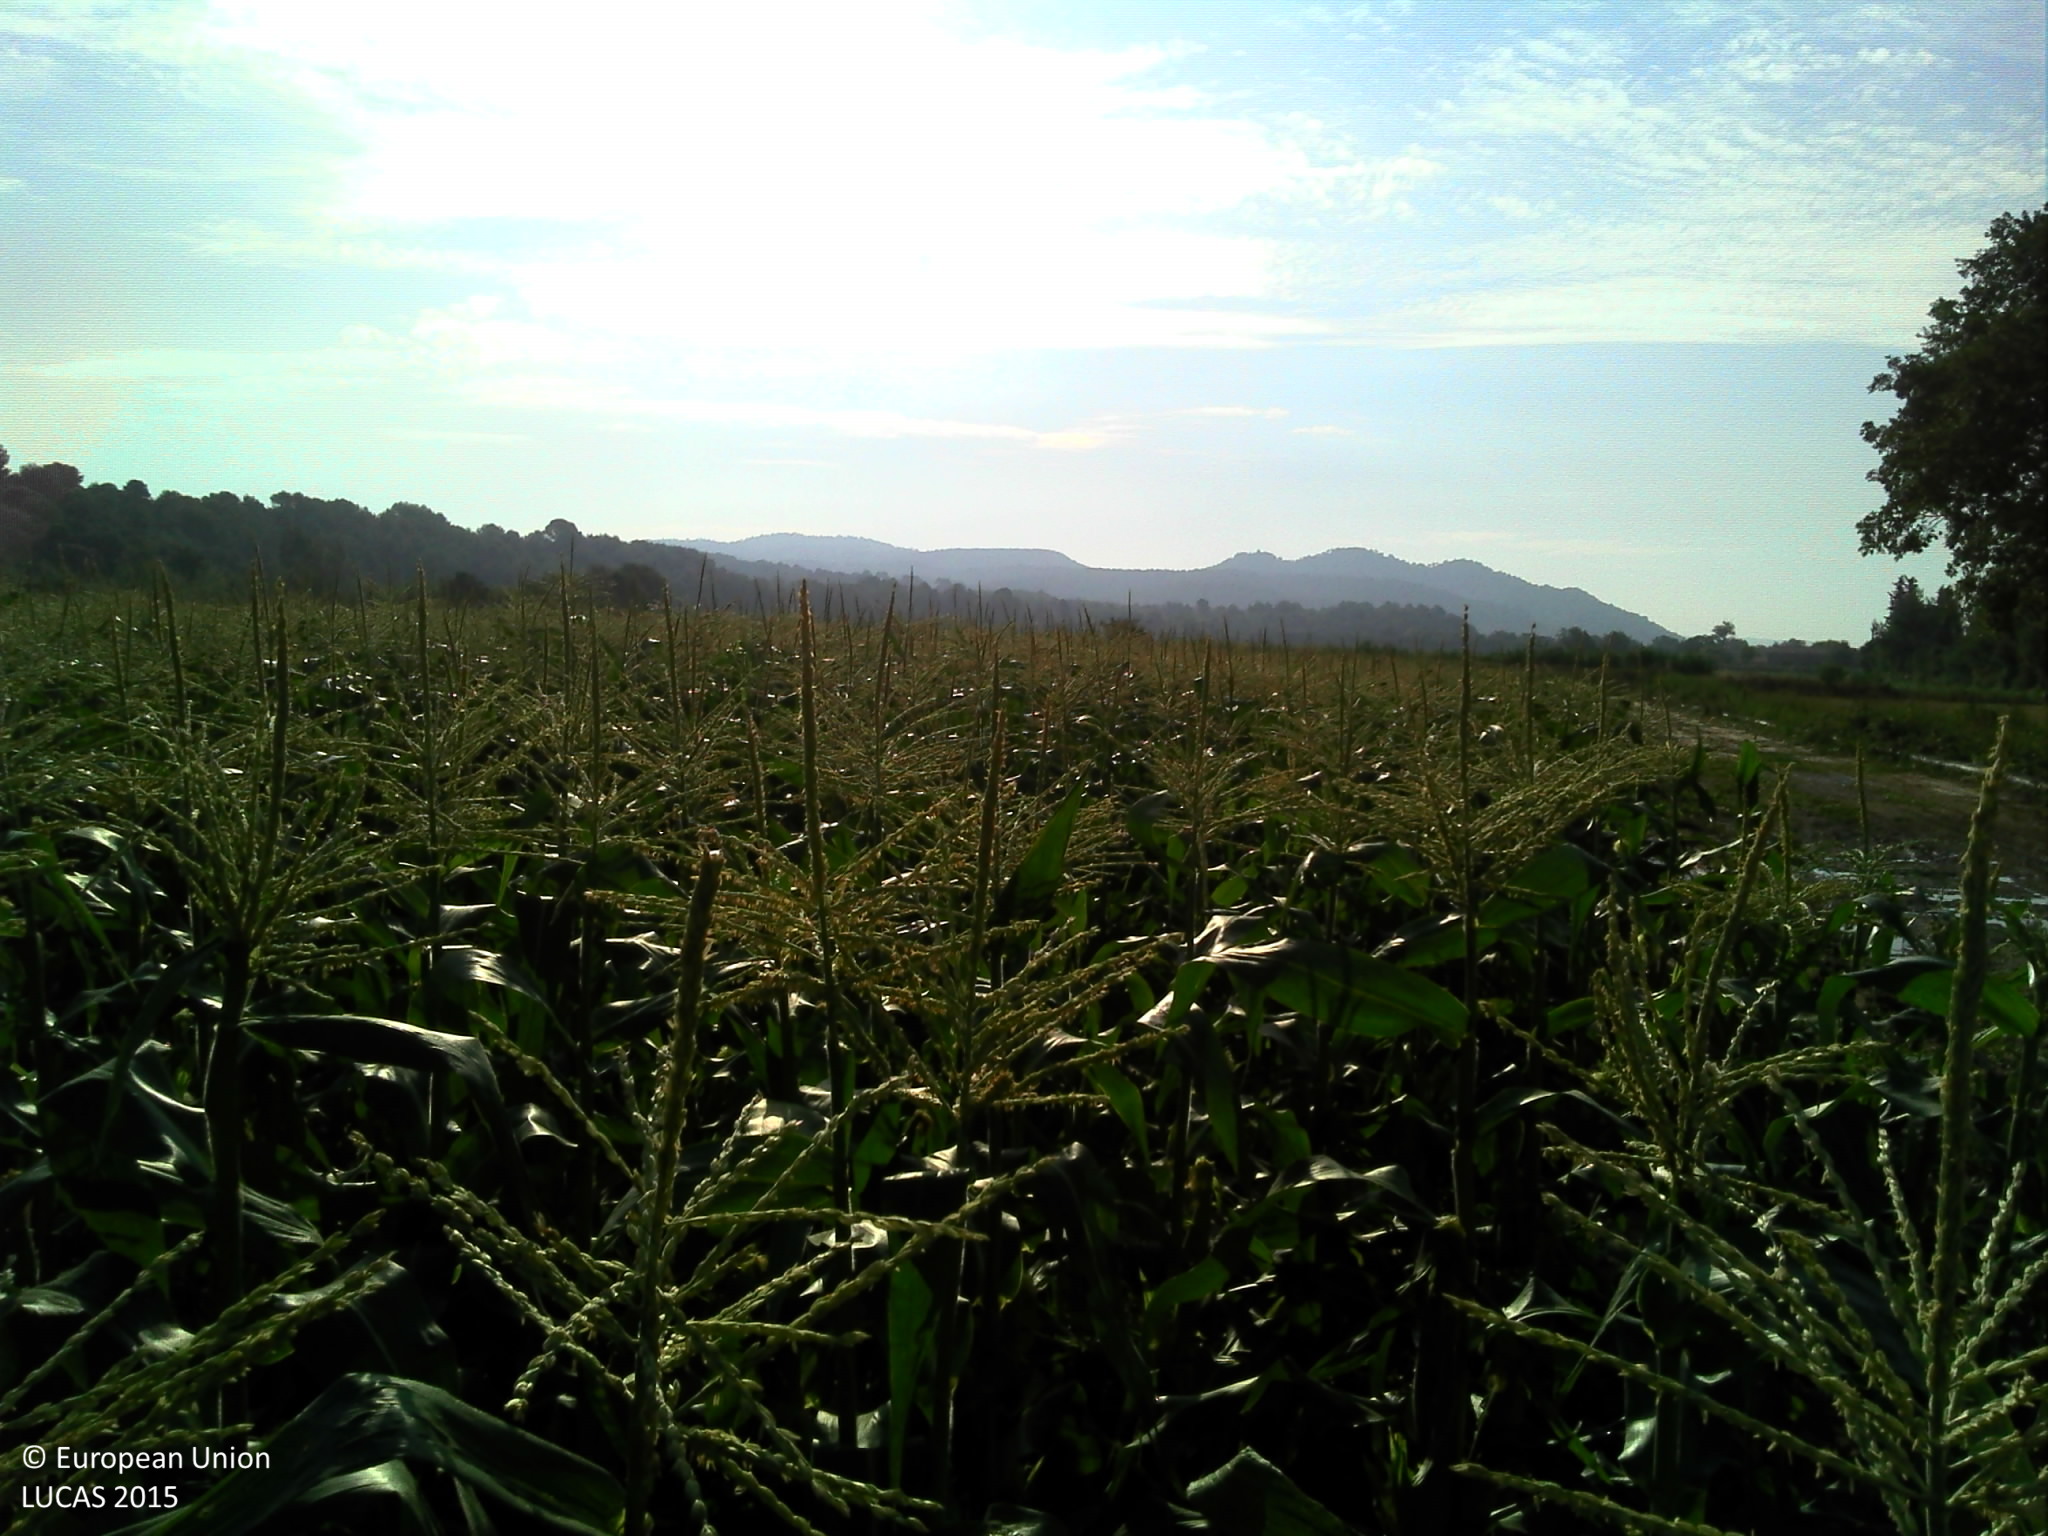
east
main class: Cropland
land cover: Maize
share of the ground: > 75 %
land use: Agriculture (excluding fallow land and kitchen gardens)
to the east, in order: Maize; Tracks; Grass margins; Ditches and canals; Grass margins; Tracks; Grass margins; Ditches and canals; Grassland without tree/shrub cover; Lines of trees; Ditches and canals; Grass margins; Durum wheat; Shrubland with sparse tree cover
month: July
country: FR
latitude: 43.6762
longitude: 5.5315
